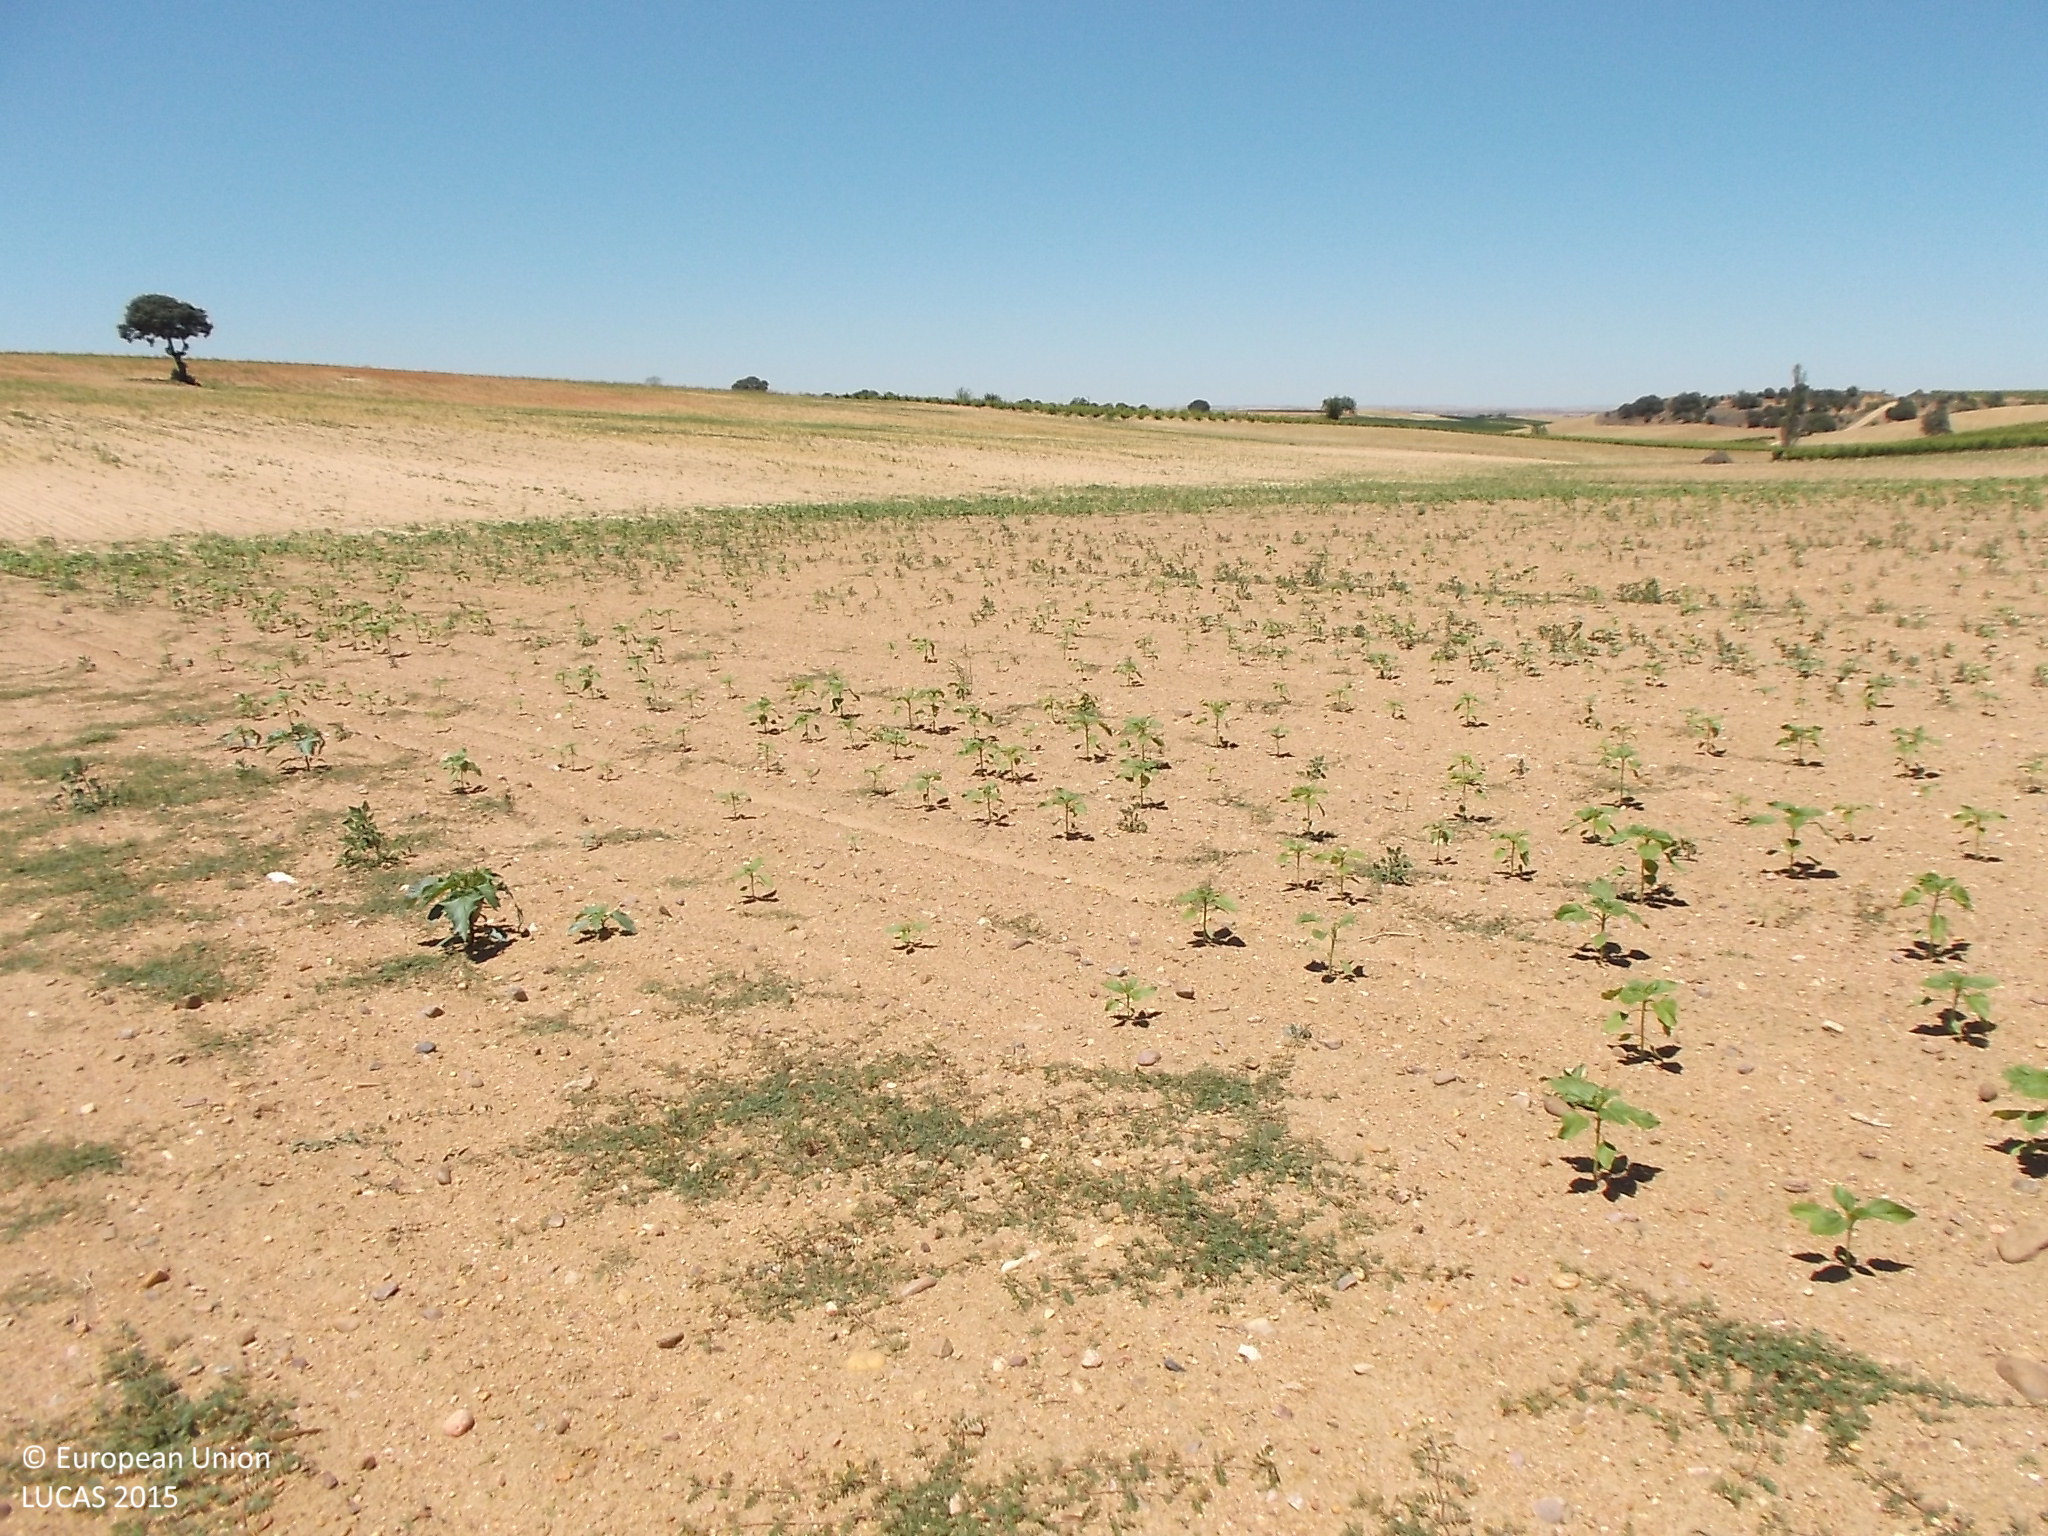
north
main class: Cropland
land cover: Barley
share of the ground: > 75 %
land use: Agriculture (excluding fallow land and kitchen gardens)
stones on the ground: < 10 %
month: June
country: ES
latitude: 41.4021
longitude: -5.3521
